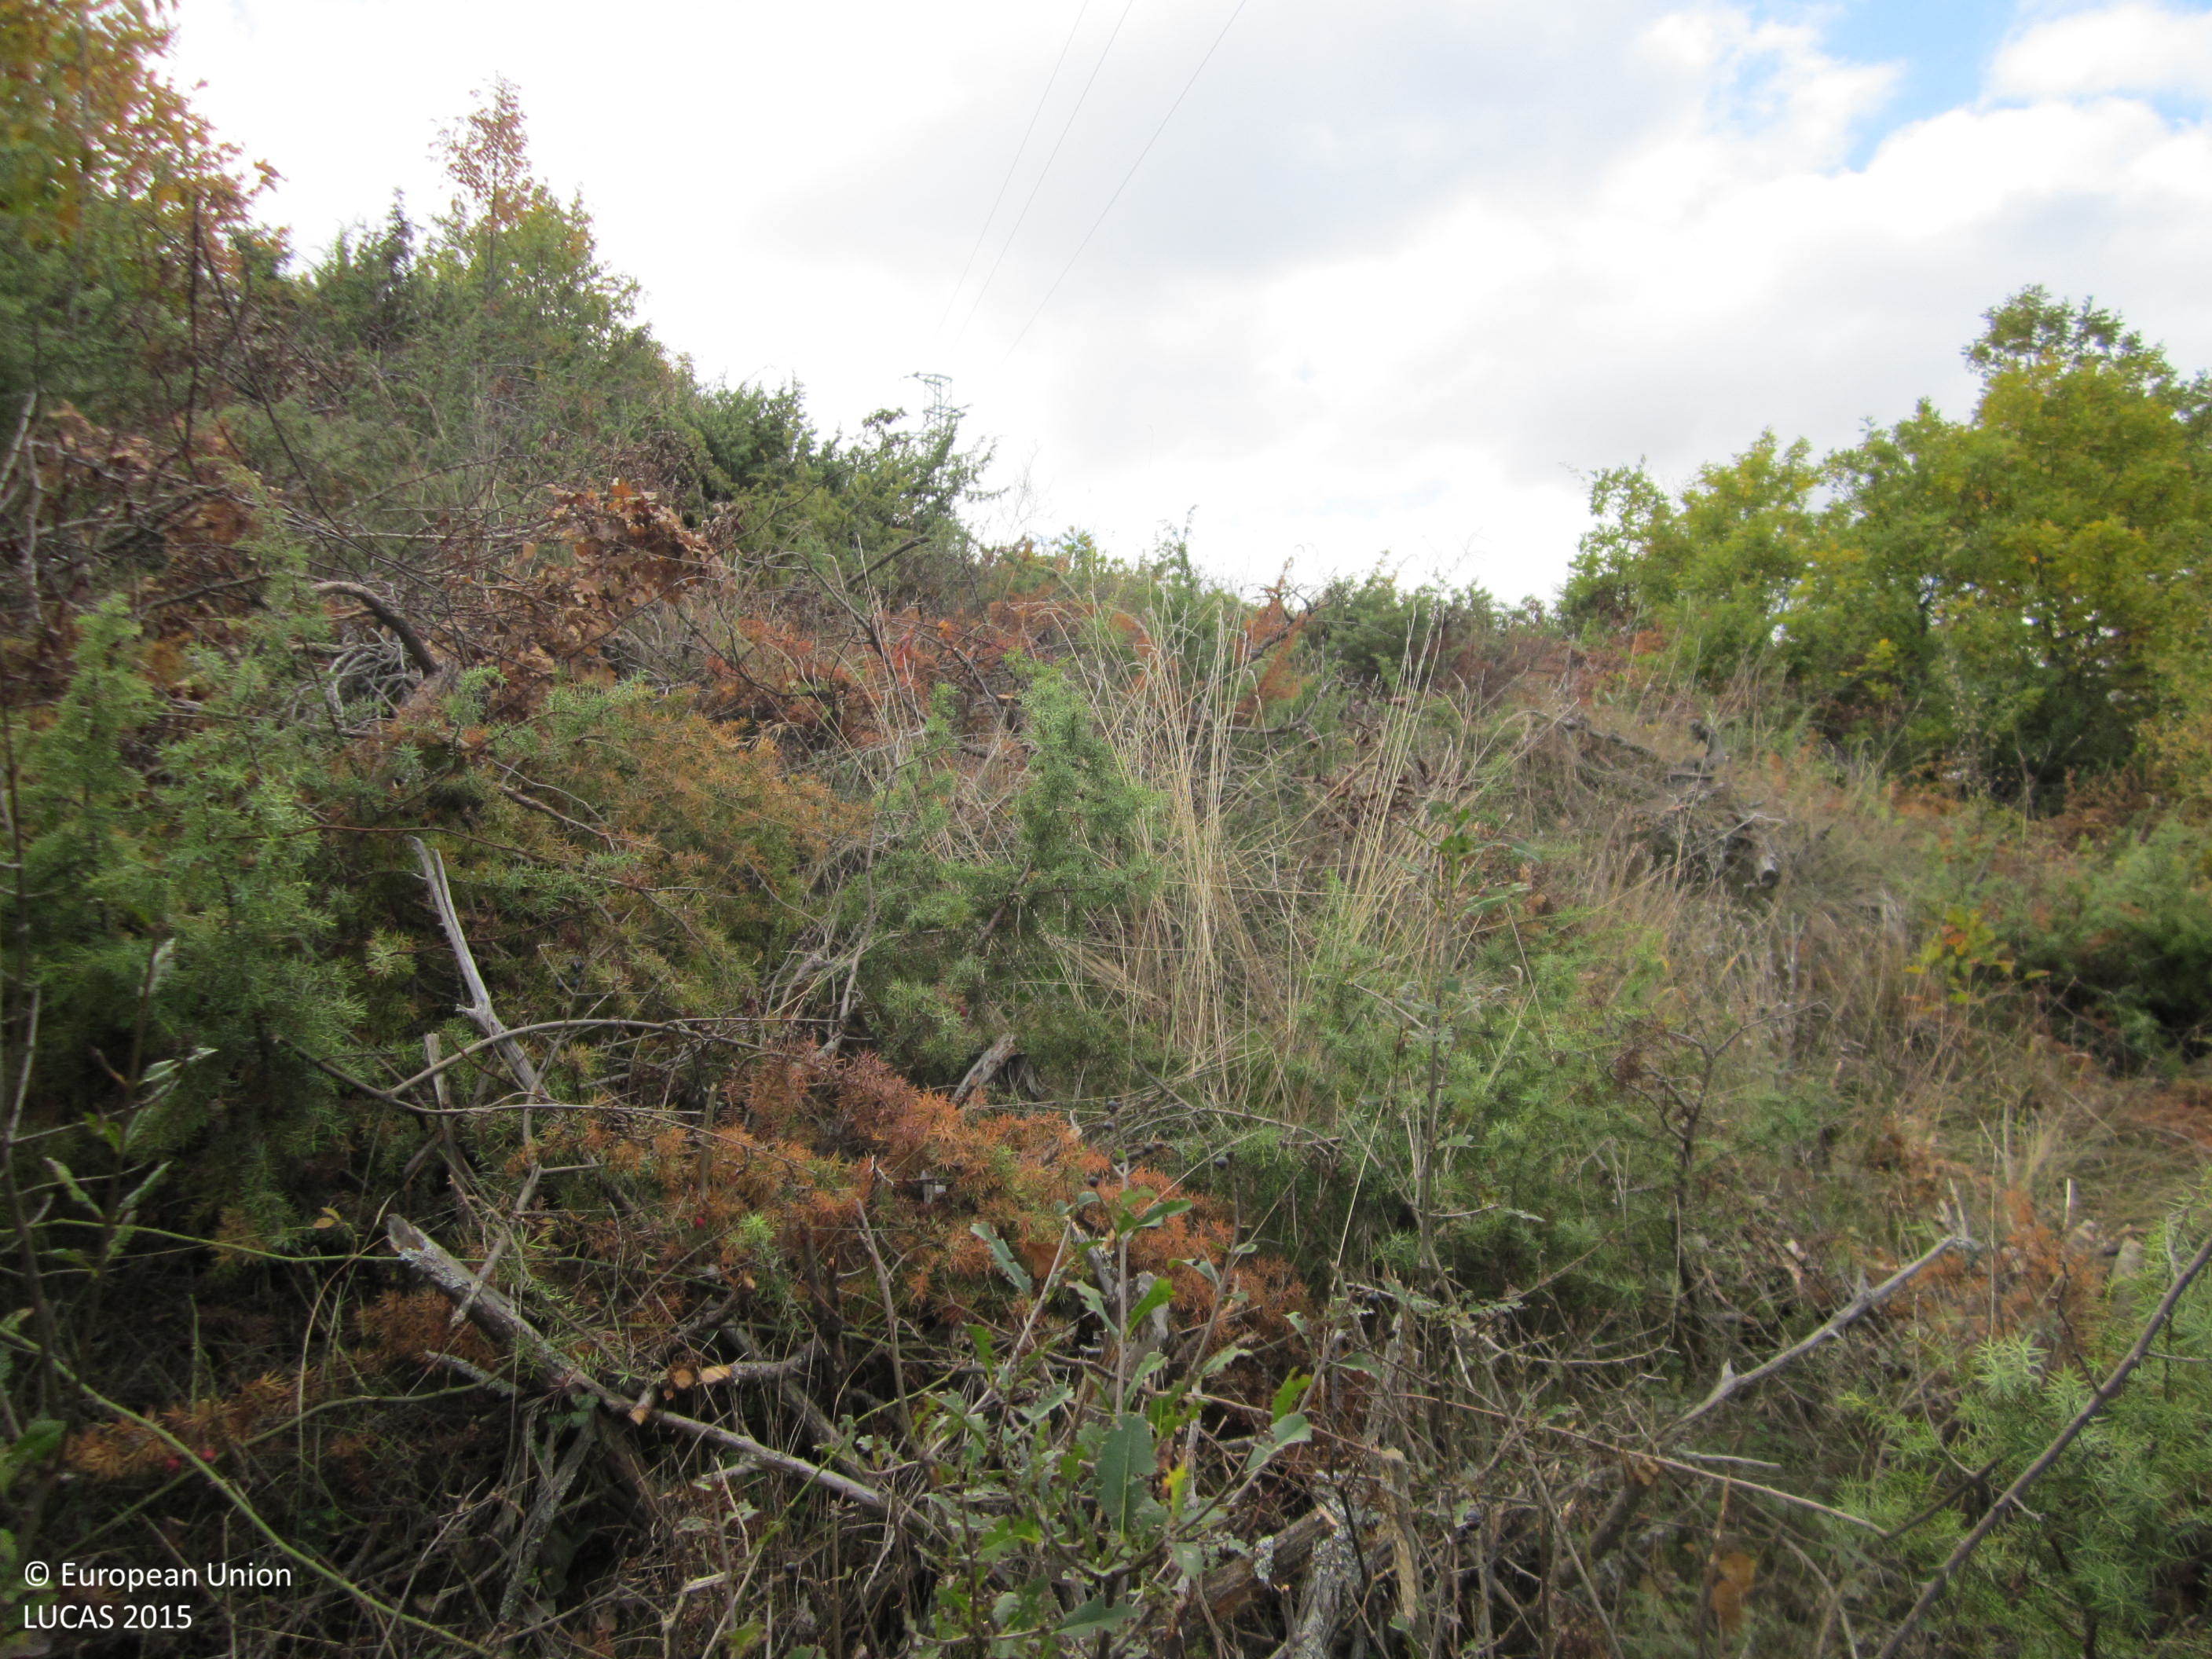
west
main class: Woodland
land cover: Broadleaved woodland
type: mesophytic deciduous forest
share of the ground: 50 - 75 %
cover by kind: broadleaved forest trees 50 %, herbaceous plants 25 %, shrubs 20 %, coniferous forest trees 5 %
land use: Forestry
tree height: > 5 m
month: November
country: BG
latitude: 41.3770
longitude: 25.8581
